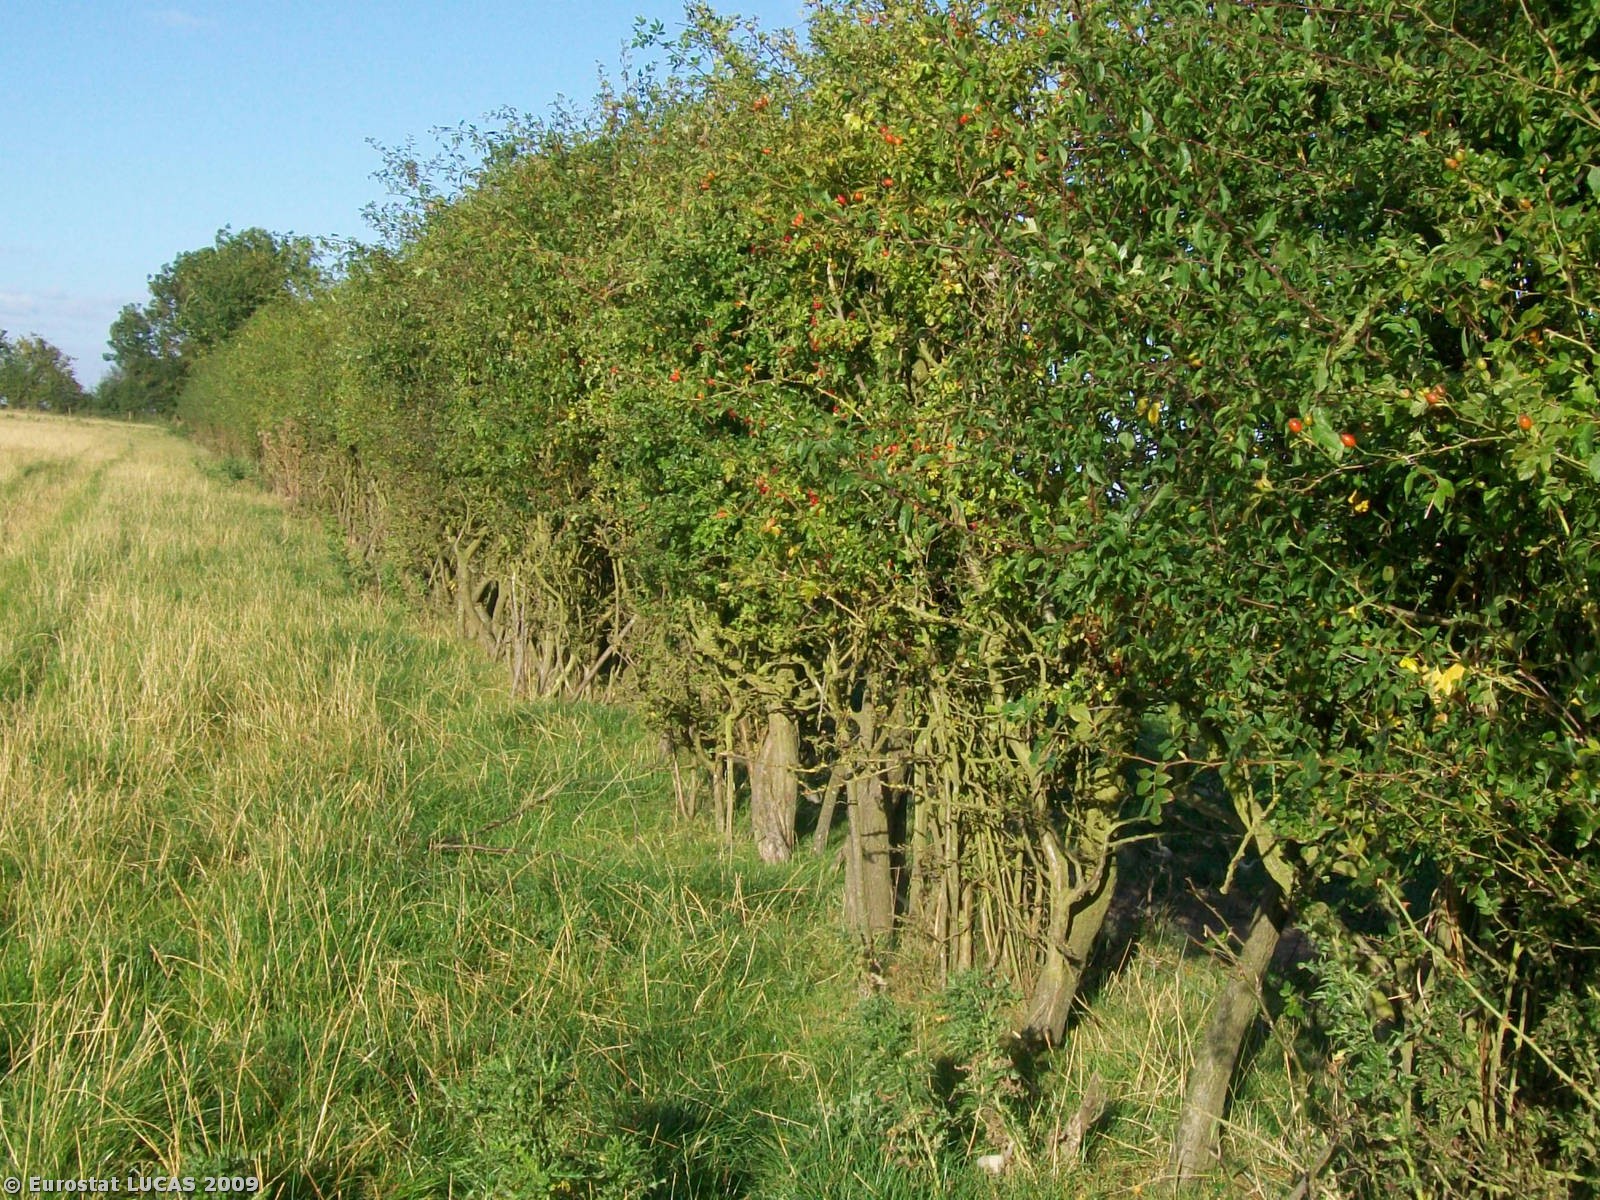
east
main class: Grassland
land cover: Grassland without tree/shrub cover
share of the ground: > 75 %
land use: Agriculture (excluding fallow land and kitchen gardens)
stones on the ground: < 10 %
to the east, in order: Grassland without tree/shrub cover; Managed hedges; Grassland without tree/shrub cover
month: September
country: GB
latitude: 52.5916
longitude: -2.6305
